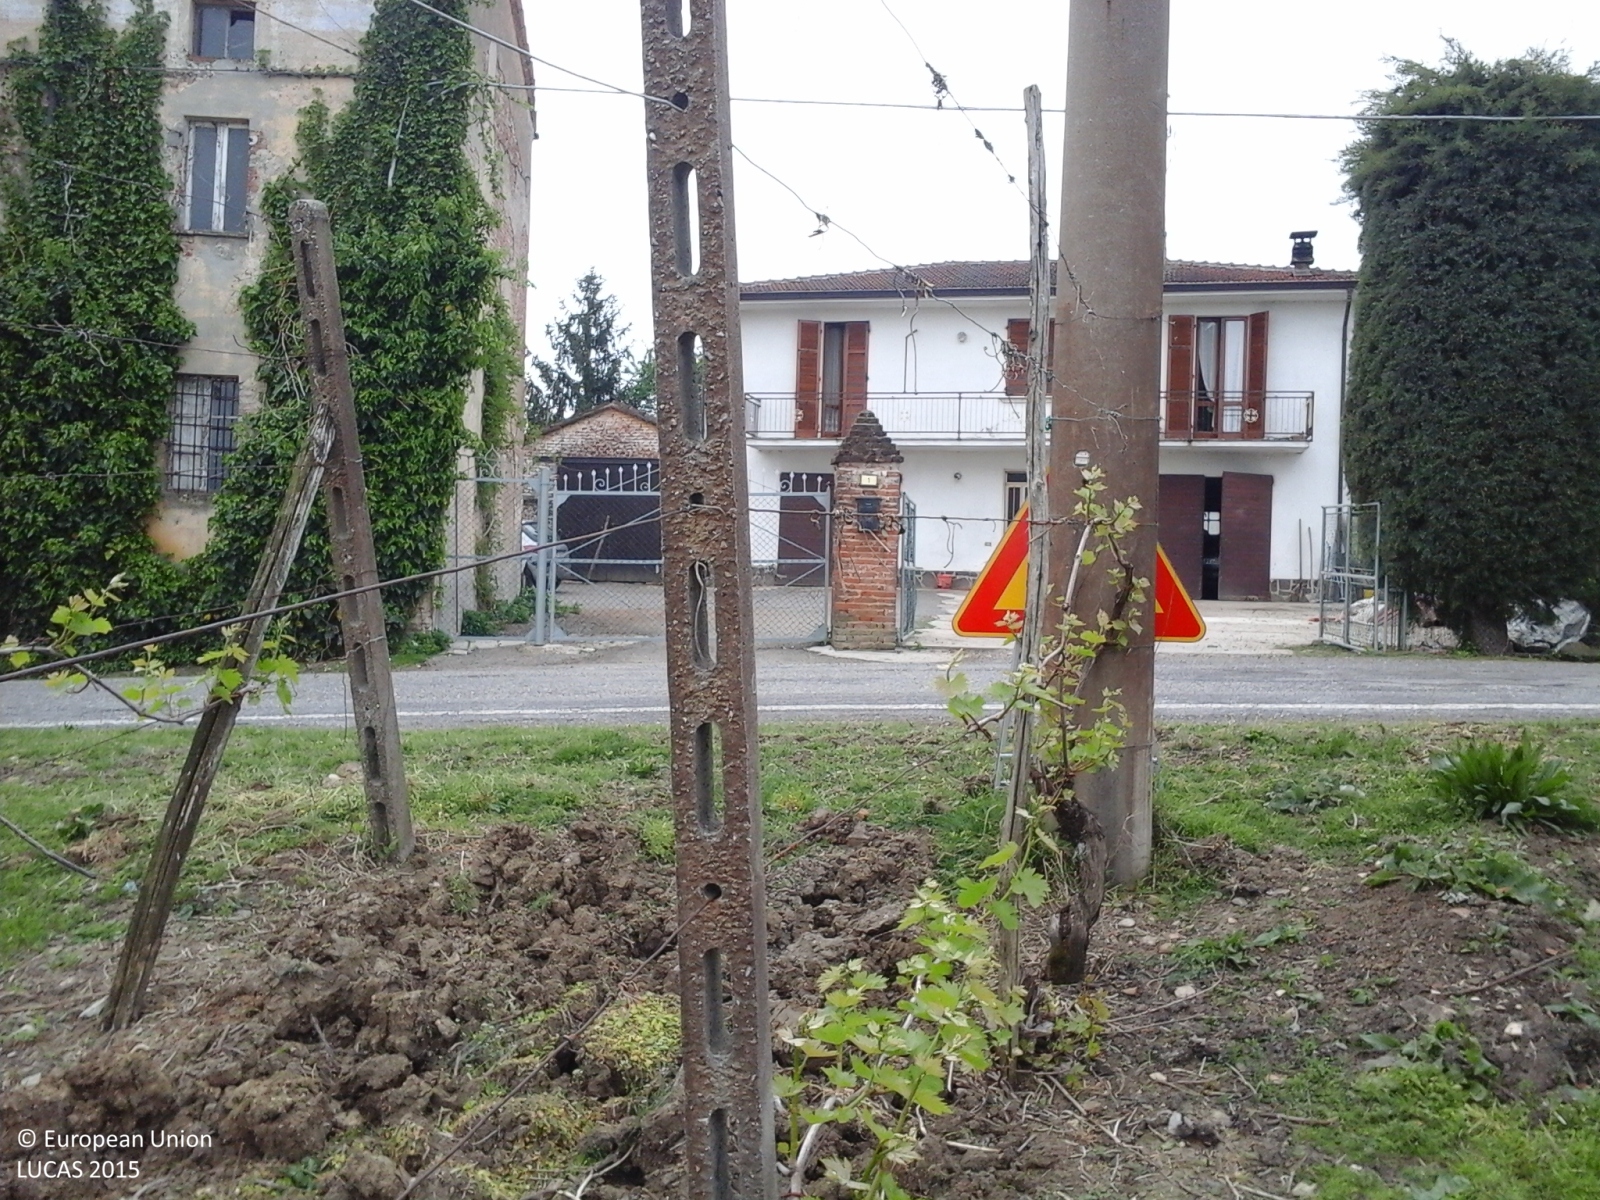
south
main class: Cropland
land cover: Vineyards
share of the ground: < 10 %
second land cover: Spontaneously vegetated surfaces
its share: > 75 %
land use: Agriculture (excluding fallow land and kitchen gardens)
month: April
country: IT
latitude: 44.9800
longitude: 9.4051
